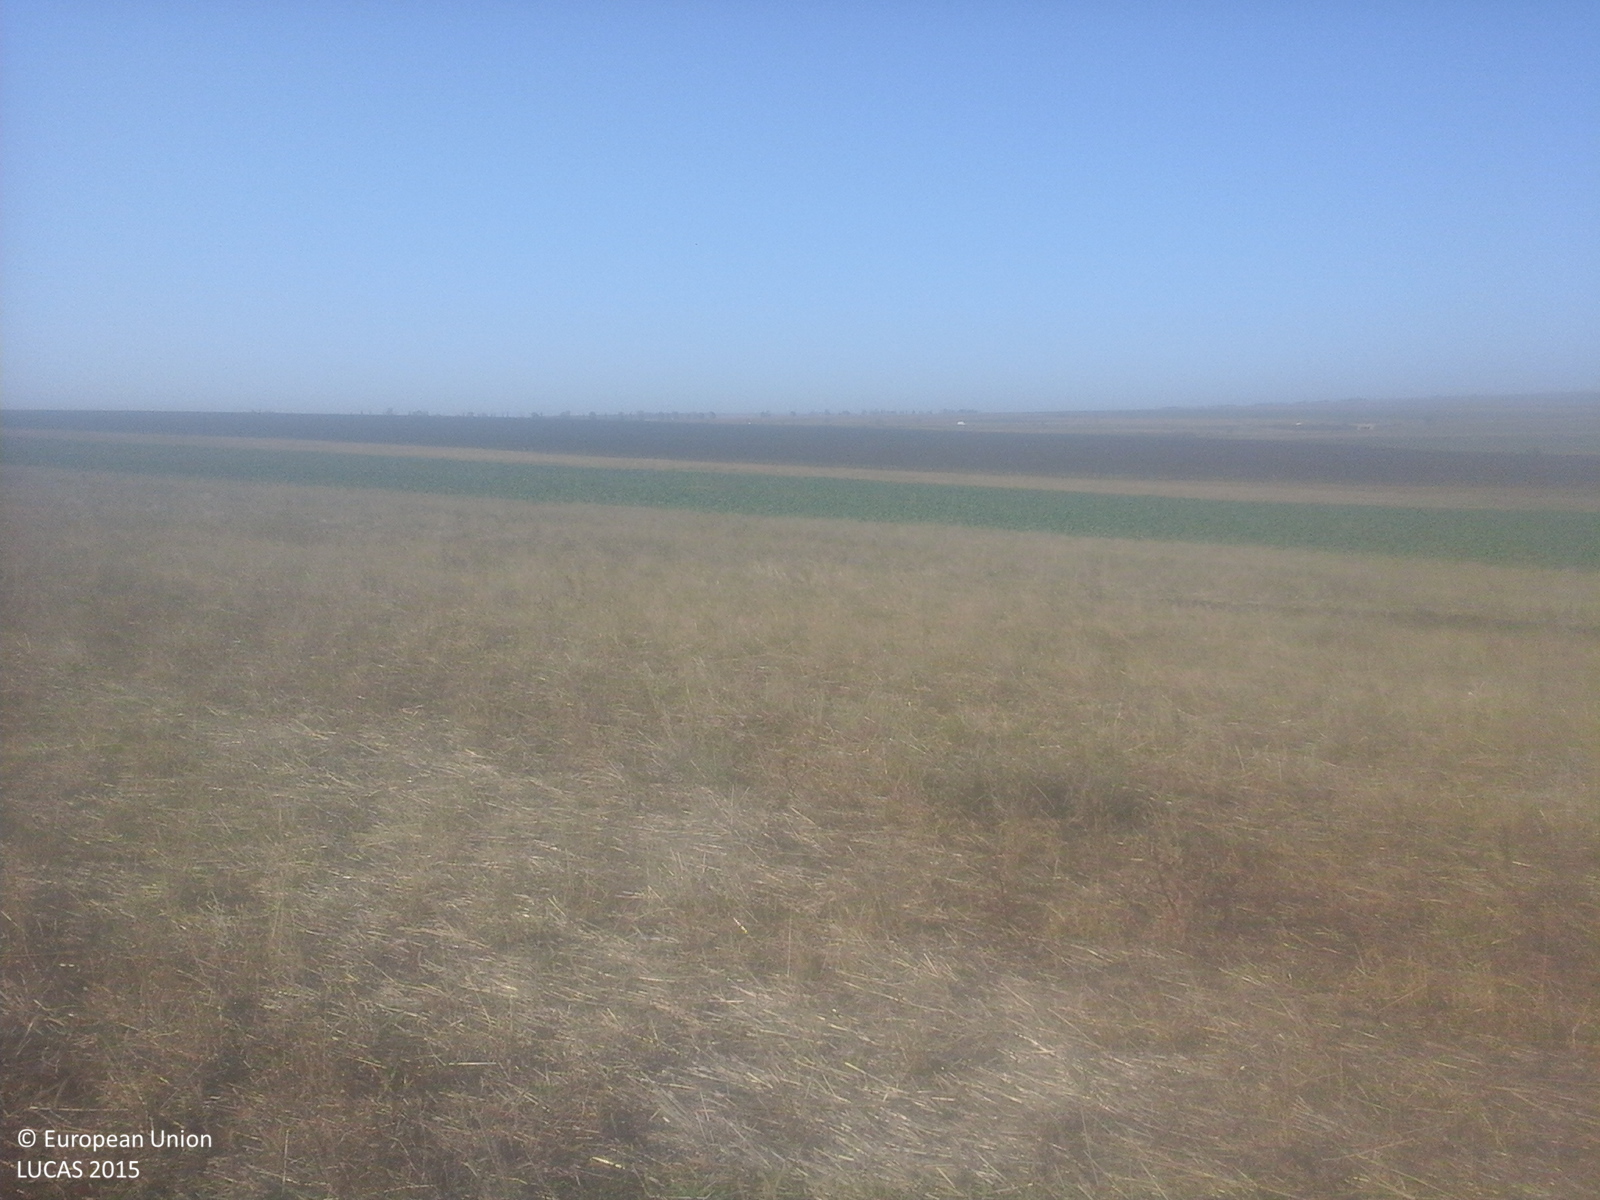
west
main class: Cropland
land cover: Common wheat
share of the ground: > 75 %
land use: Agriculture (excluding fallow land and kitchen gardens)
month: October
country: RO
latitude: 45.3149
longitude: 26.9613
